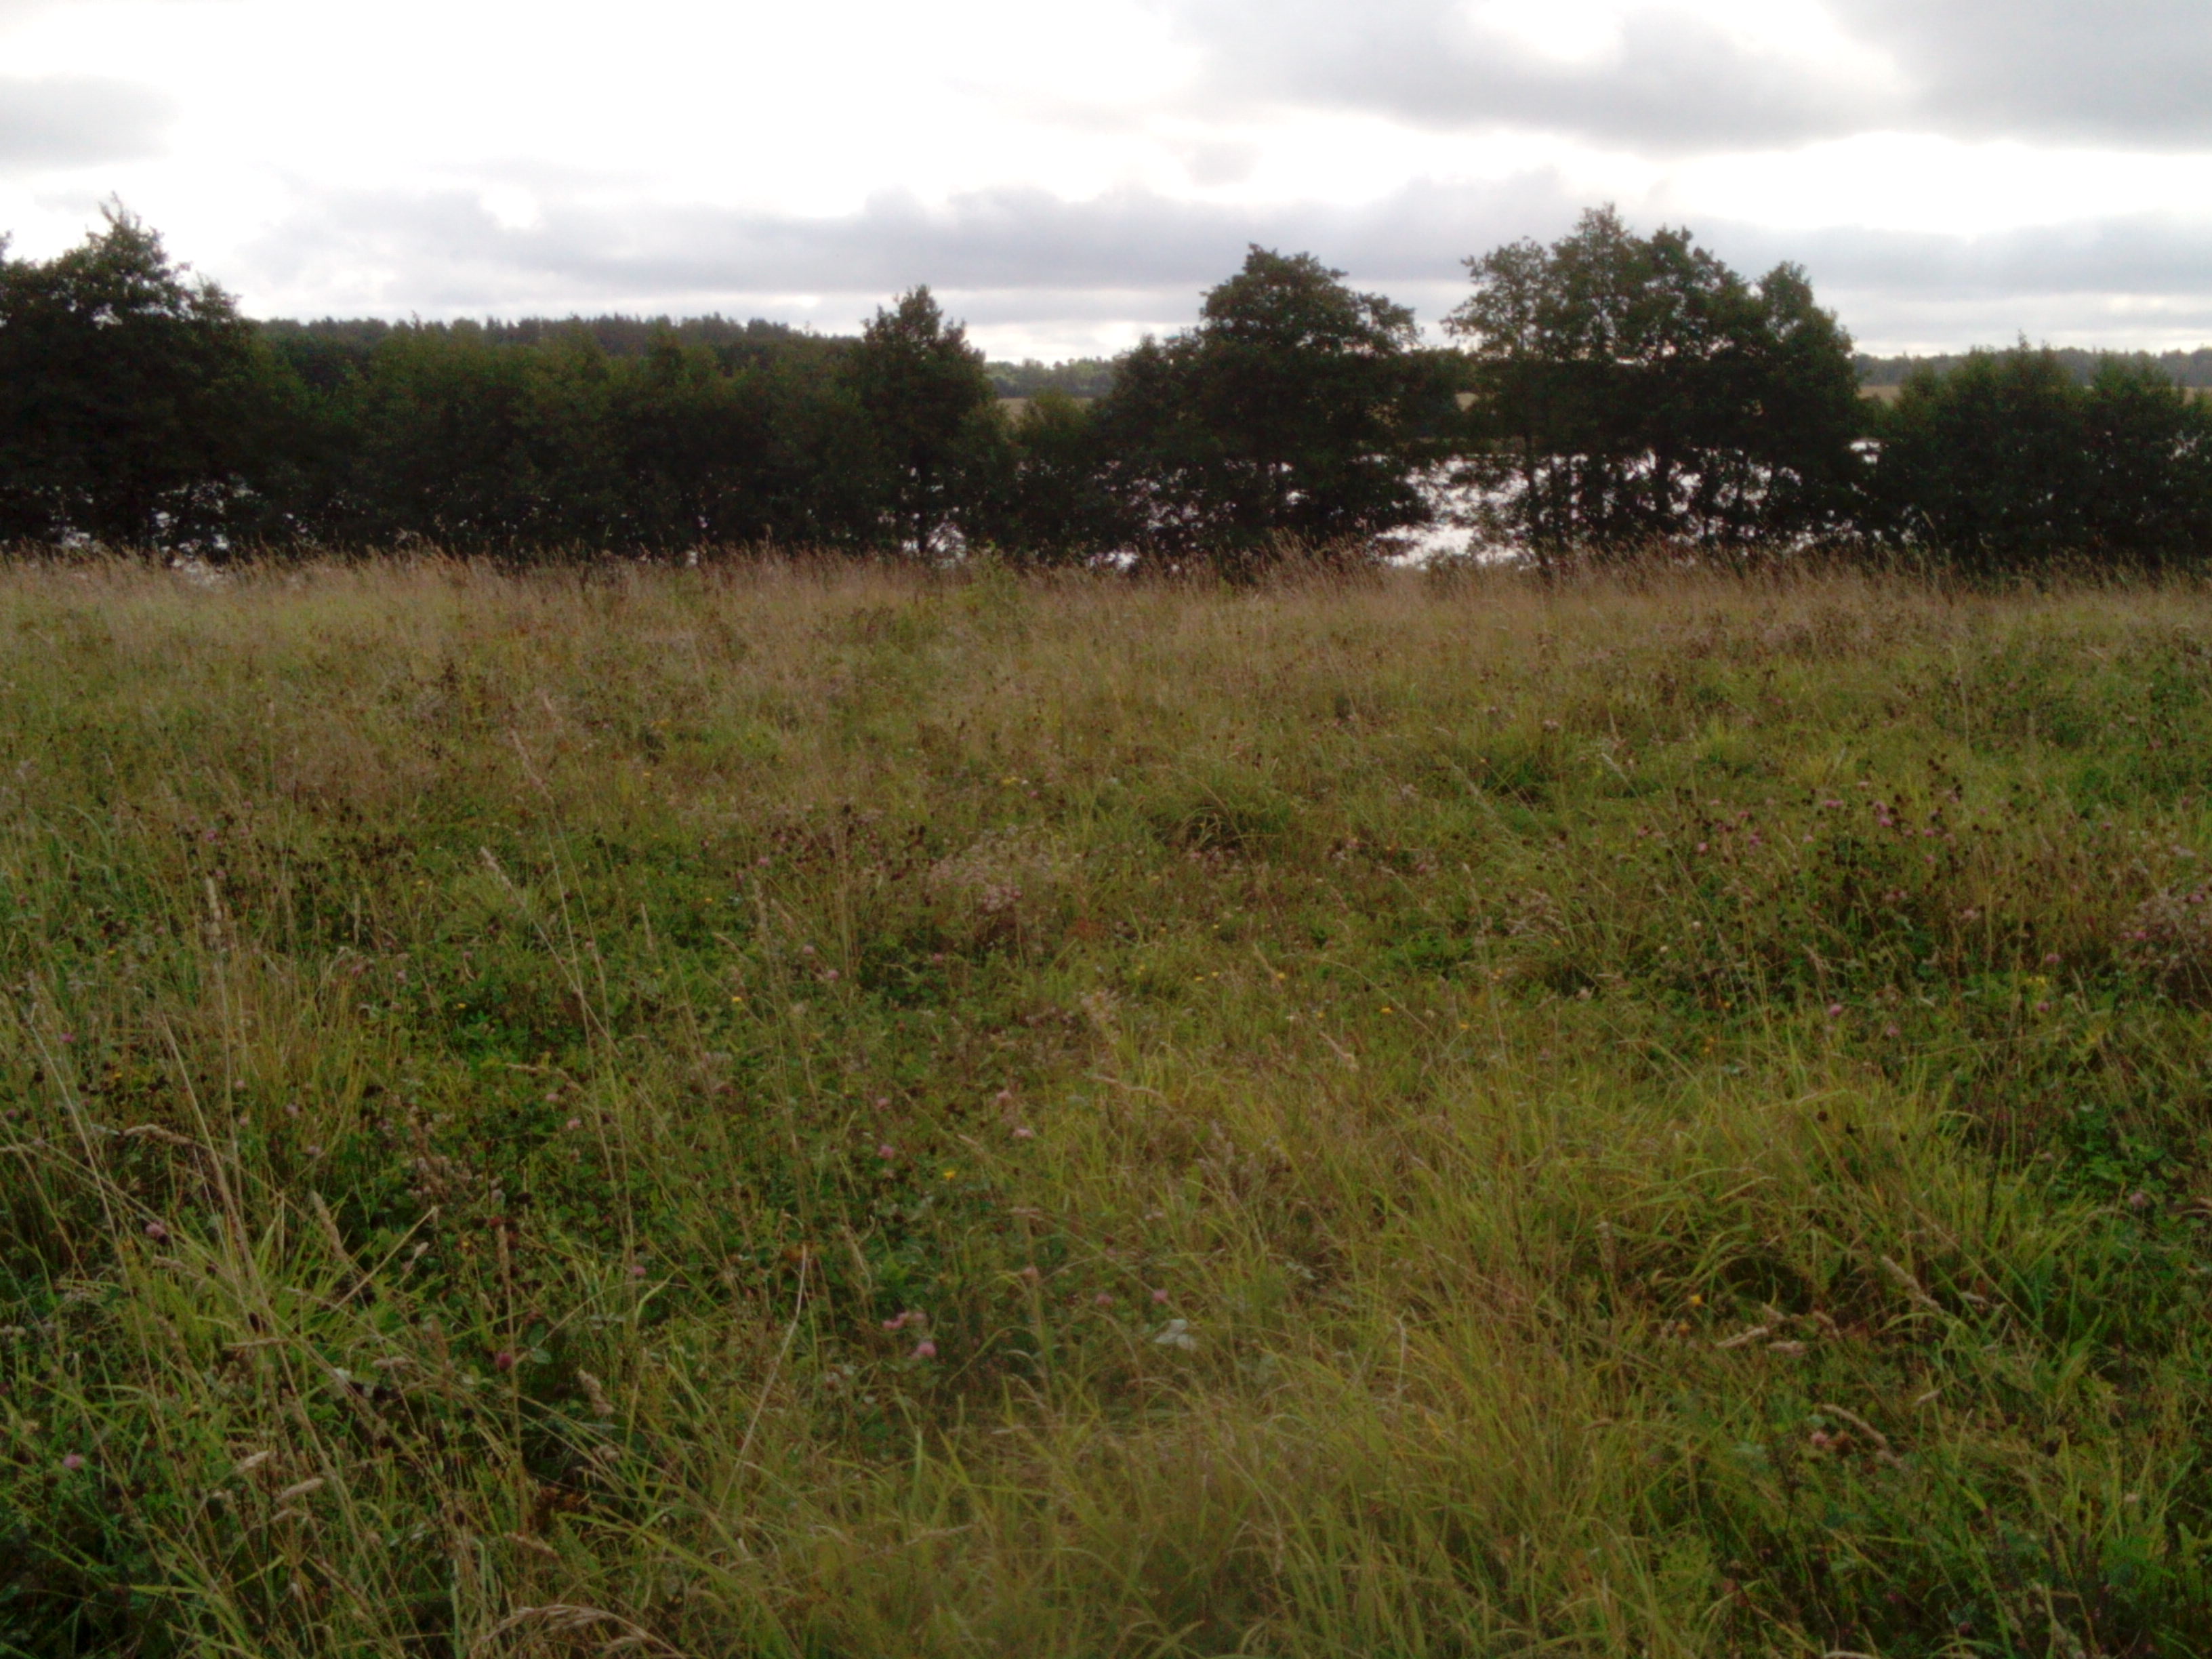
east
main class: Grassland
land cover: Grassland without tree/shrub cover
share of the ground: > 75 %
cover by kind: herbaceous plants 100 %
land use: Agriculture (excluding fallow land and kitchen gardens)
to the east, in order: Grassland without tree/shrub cover; Grassland with sparse tree/shrub cover; Broadleaved woodland; Spontaneously vegetated surfaces; Inland marshes; Inland fresh water bodies
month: September
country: LT
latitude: 55.9450
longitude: 22.7939
